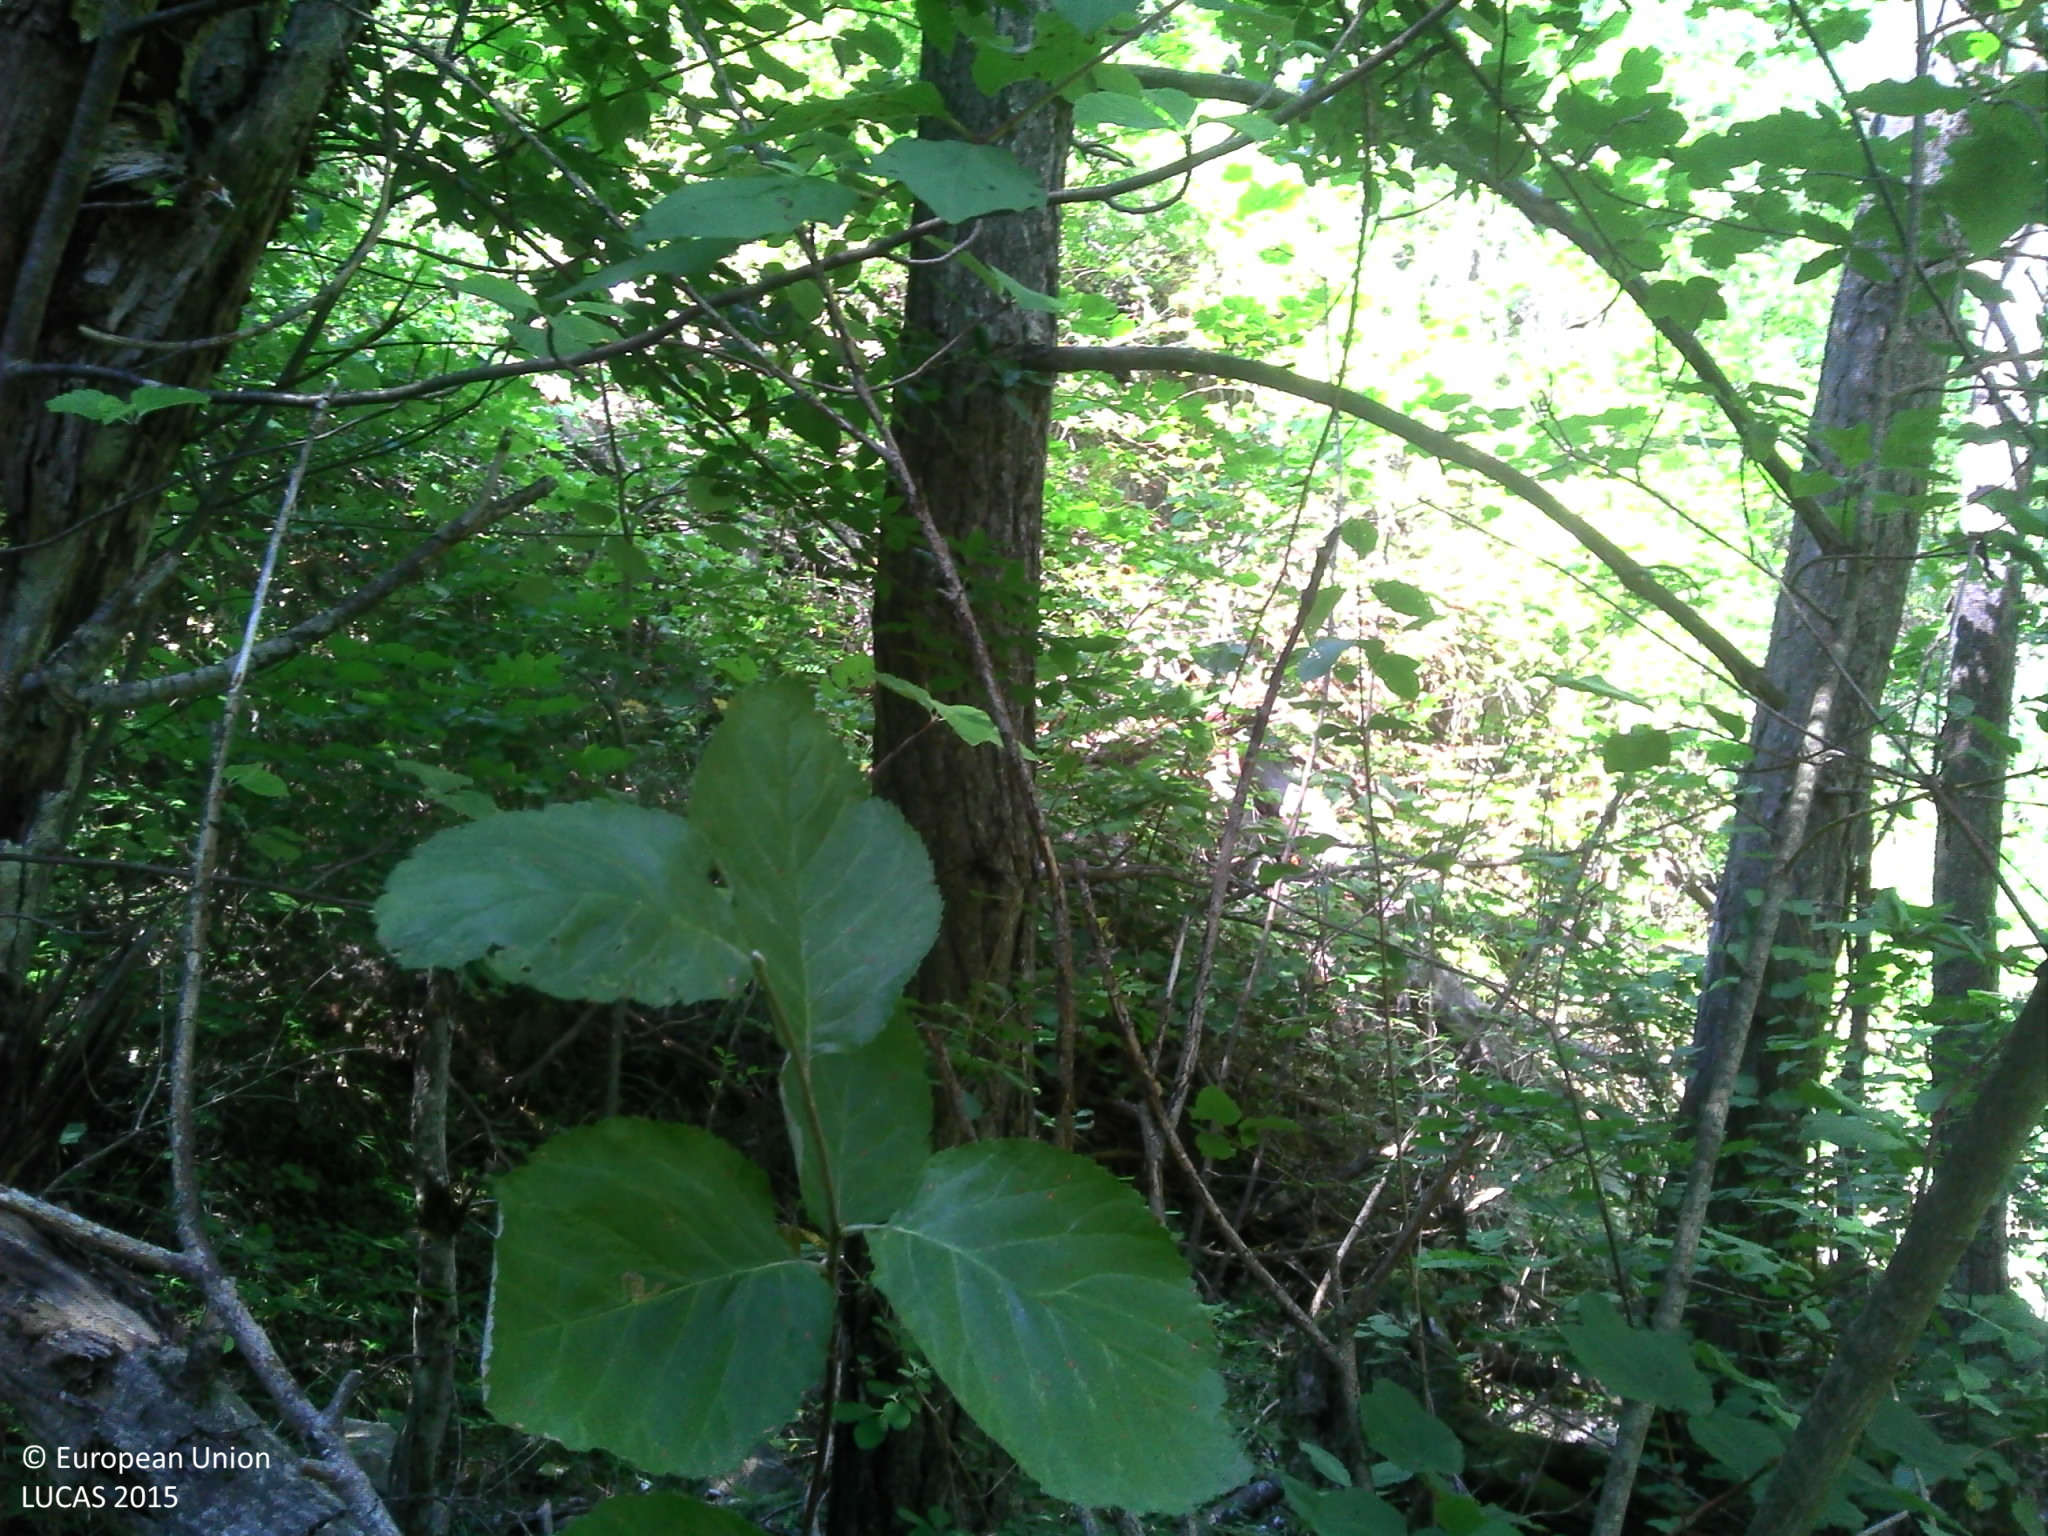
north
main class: Woodland
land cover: Pine dominated mixed woodland
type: alpine coniferous forest
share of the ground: > 75 %
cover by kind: coniferous forest trees 40 %, broadleaved forest trees 40 %, shrubs 10 %, herbaceous plants 10 %
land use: Forestry
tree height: > 5 m
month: August
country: FR
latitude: 44.3845
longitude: 6.5798
